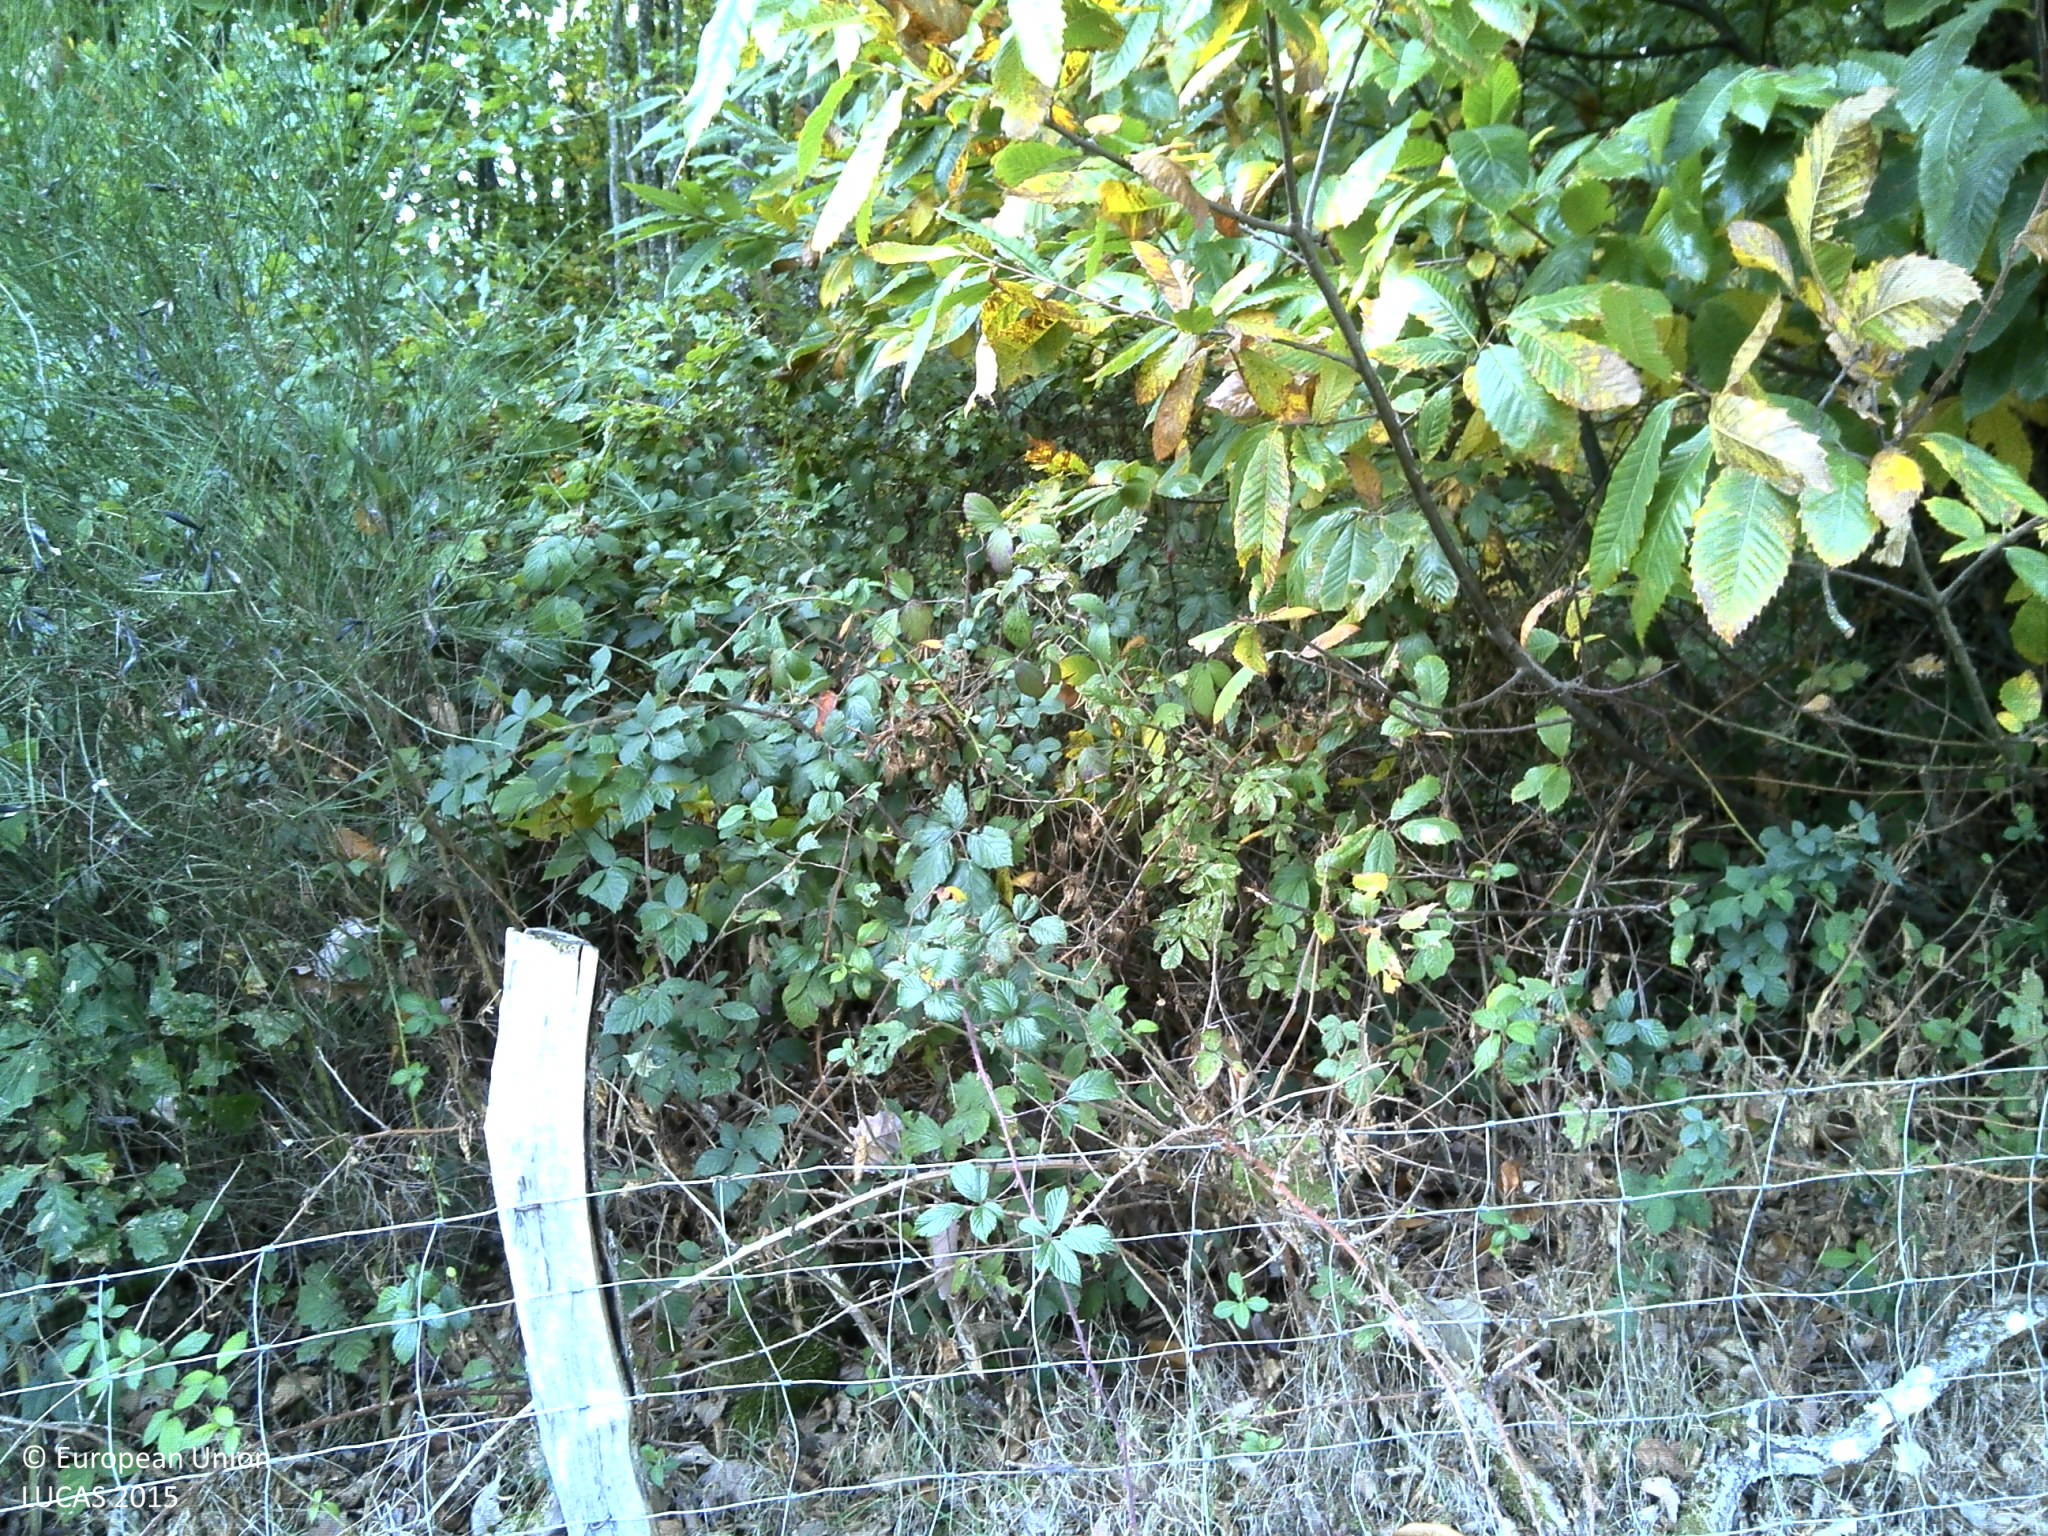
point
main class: Woodland
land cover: Broadleaved woodland
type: mesophytic deciduous forest
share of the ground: > 75 %
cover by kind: broadleaved forest trees 100 %
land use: Forestry
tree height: > 5 m
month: October
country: FR
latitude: 46.6897
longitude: 4.0242
